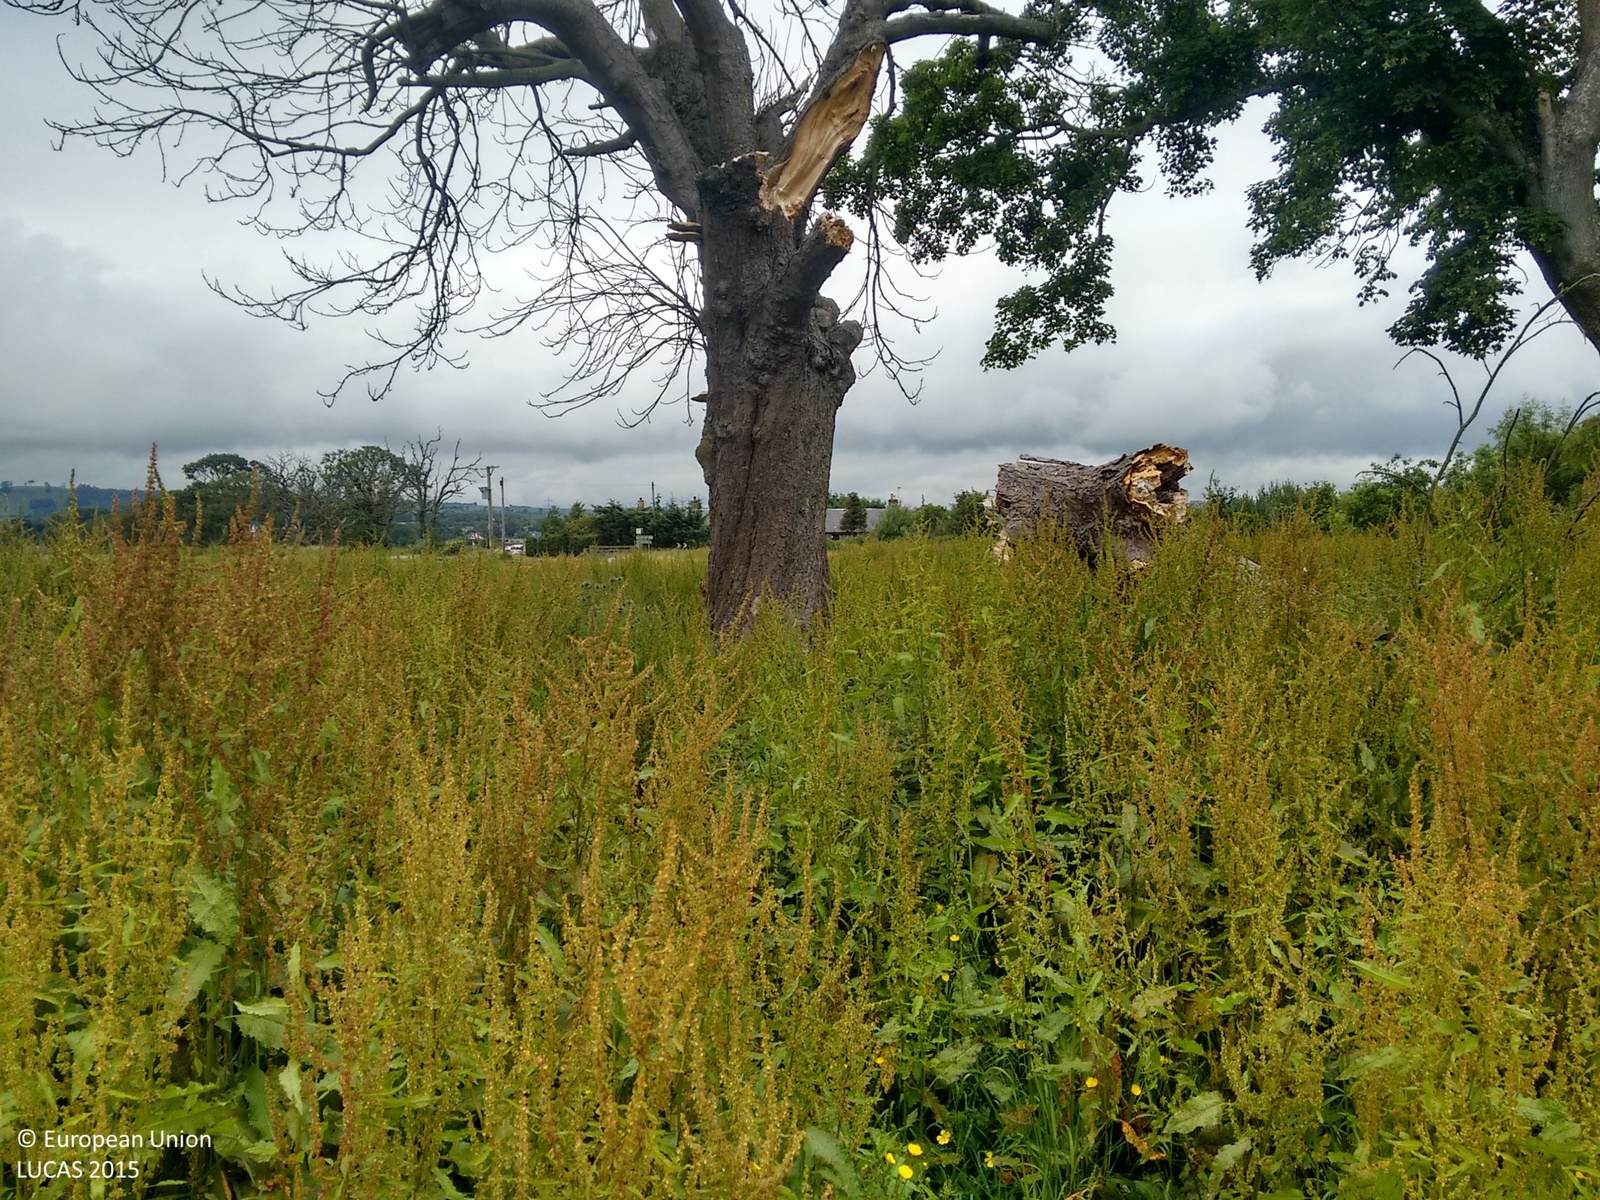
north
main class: Woodland
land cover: Broadleaved woodland
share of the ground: > 75 %
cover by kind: herbaceous plants 80 %, broadleaved forest trees 20 %
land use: Agriculture (excluding fallow land and kitchen gardens)
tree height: > 5 m
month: July
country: GB
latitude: 56.4403
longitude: -3.1253
